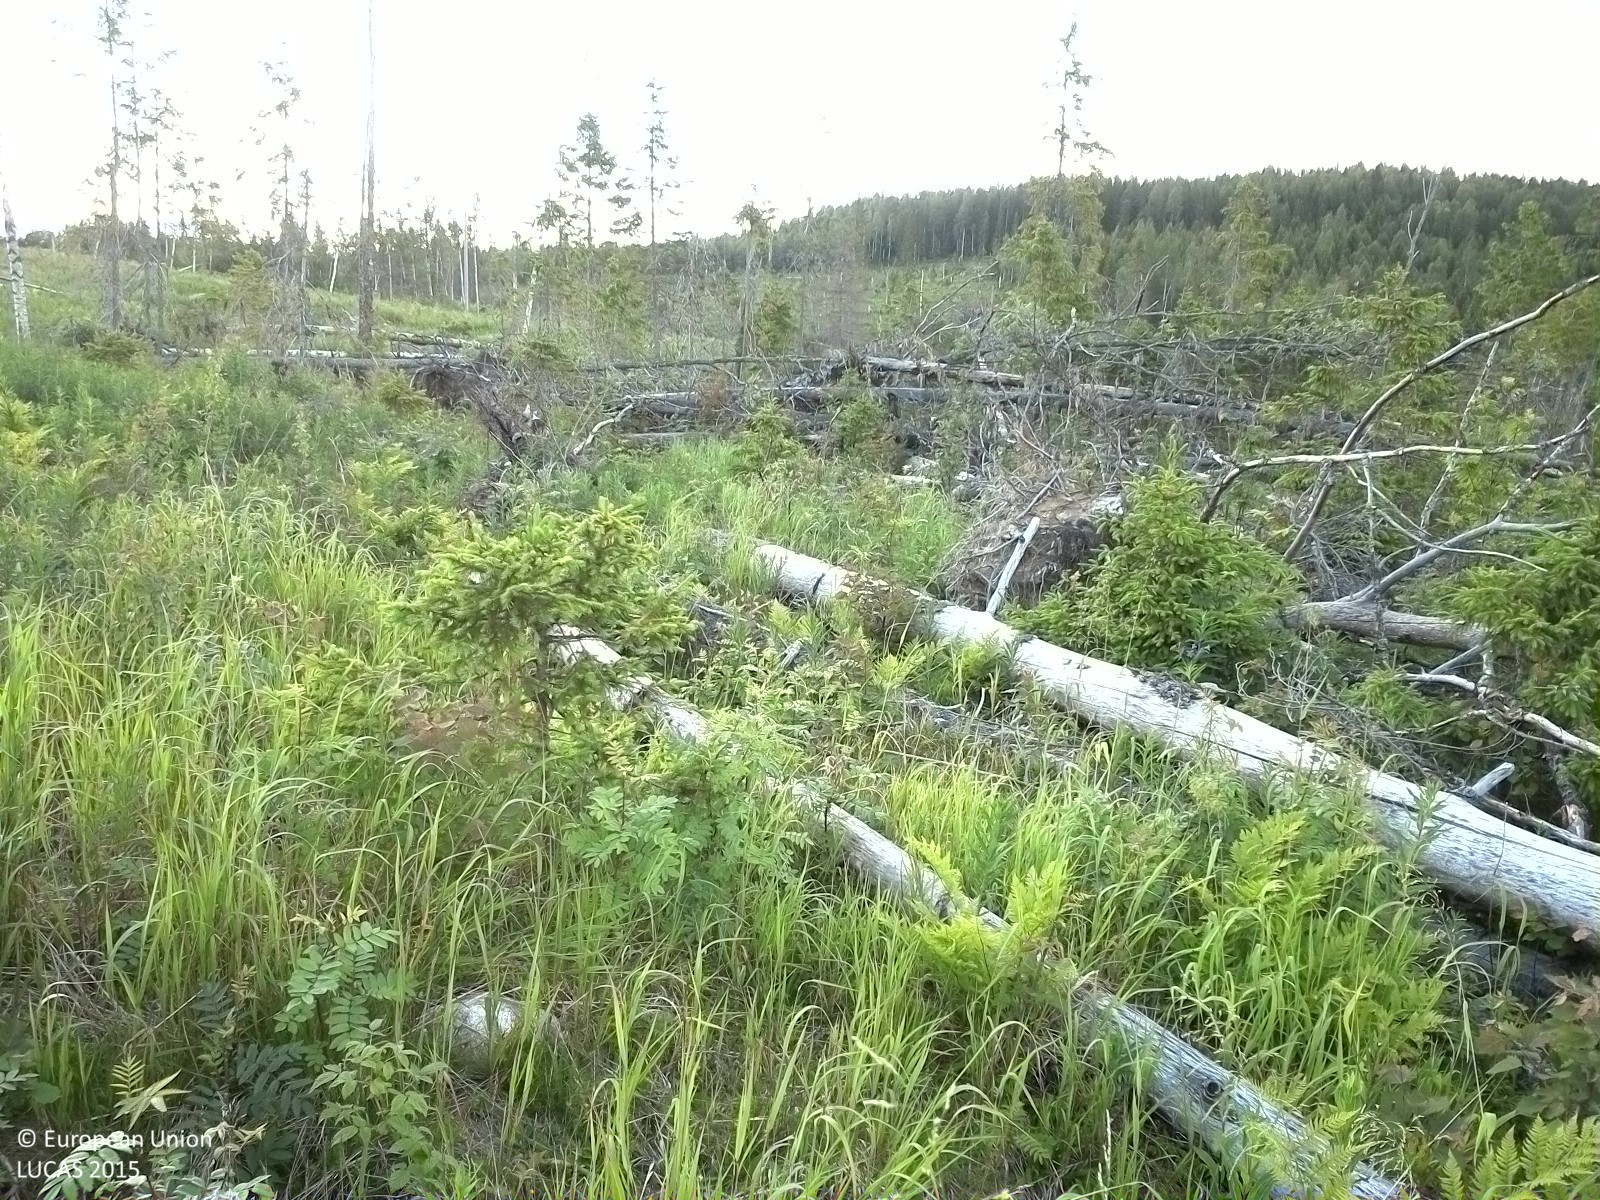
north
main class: Woodland
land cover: Broadleaved woodland
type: boreal forest
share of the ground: 10 - 25 %
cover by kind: herbaceous plants 65 %, unconsolidated bare surface 20 %, broadleaved forest trees 15 %
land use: Forestry
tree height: < 5 m
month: July
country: SE
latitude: 62.1889
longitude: 16.7630
